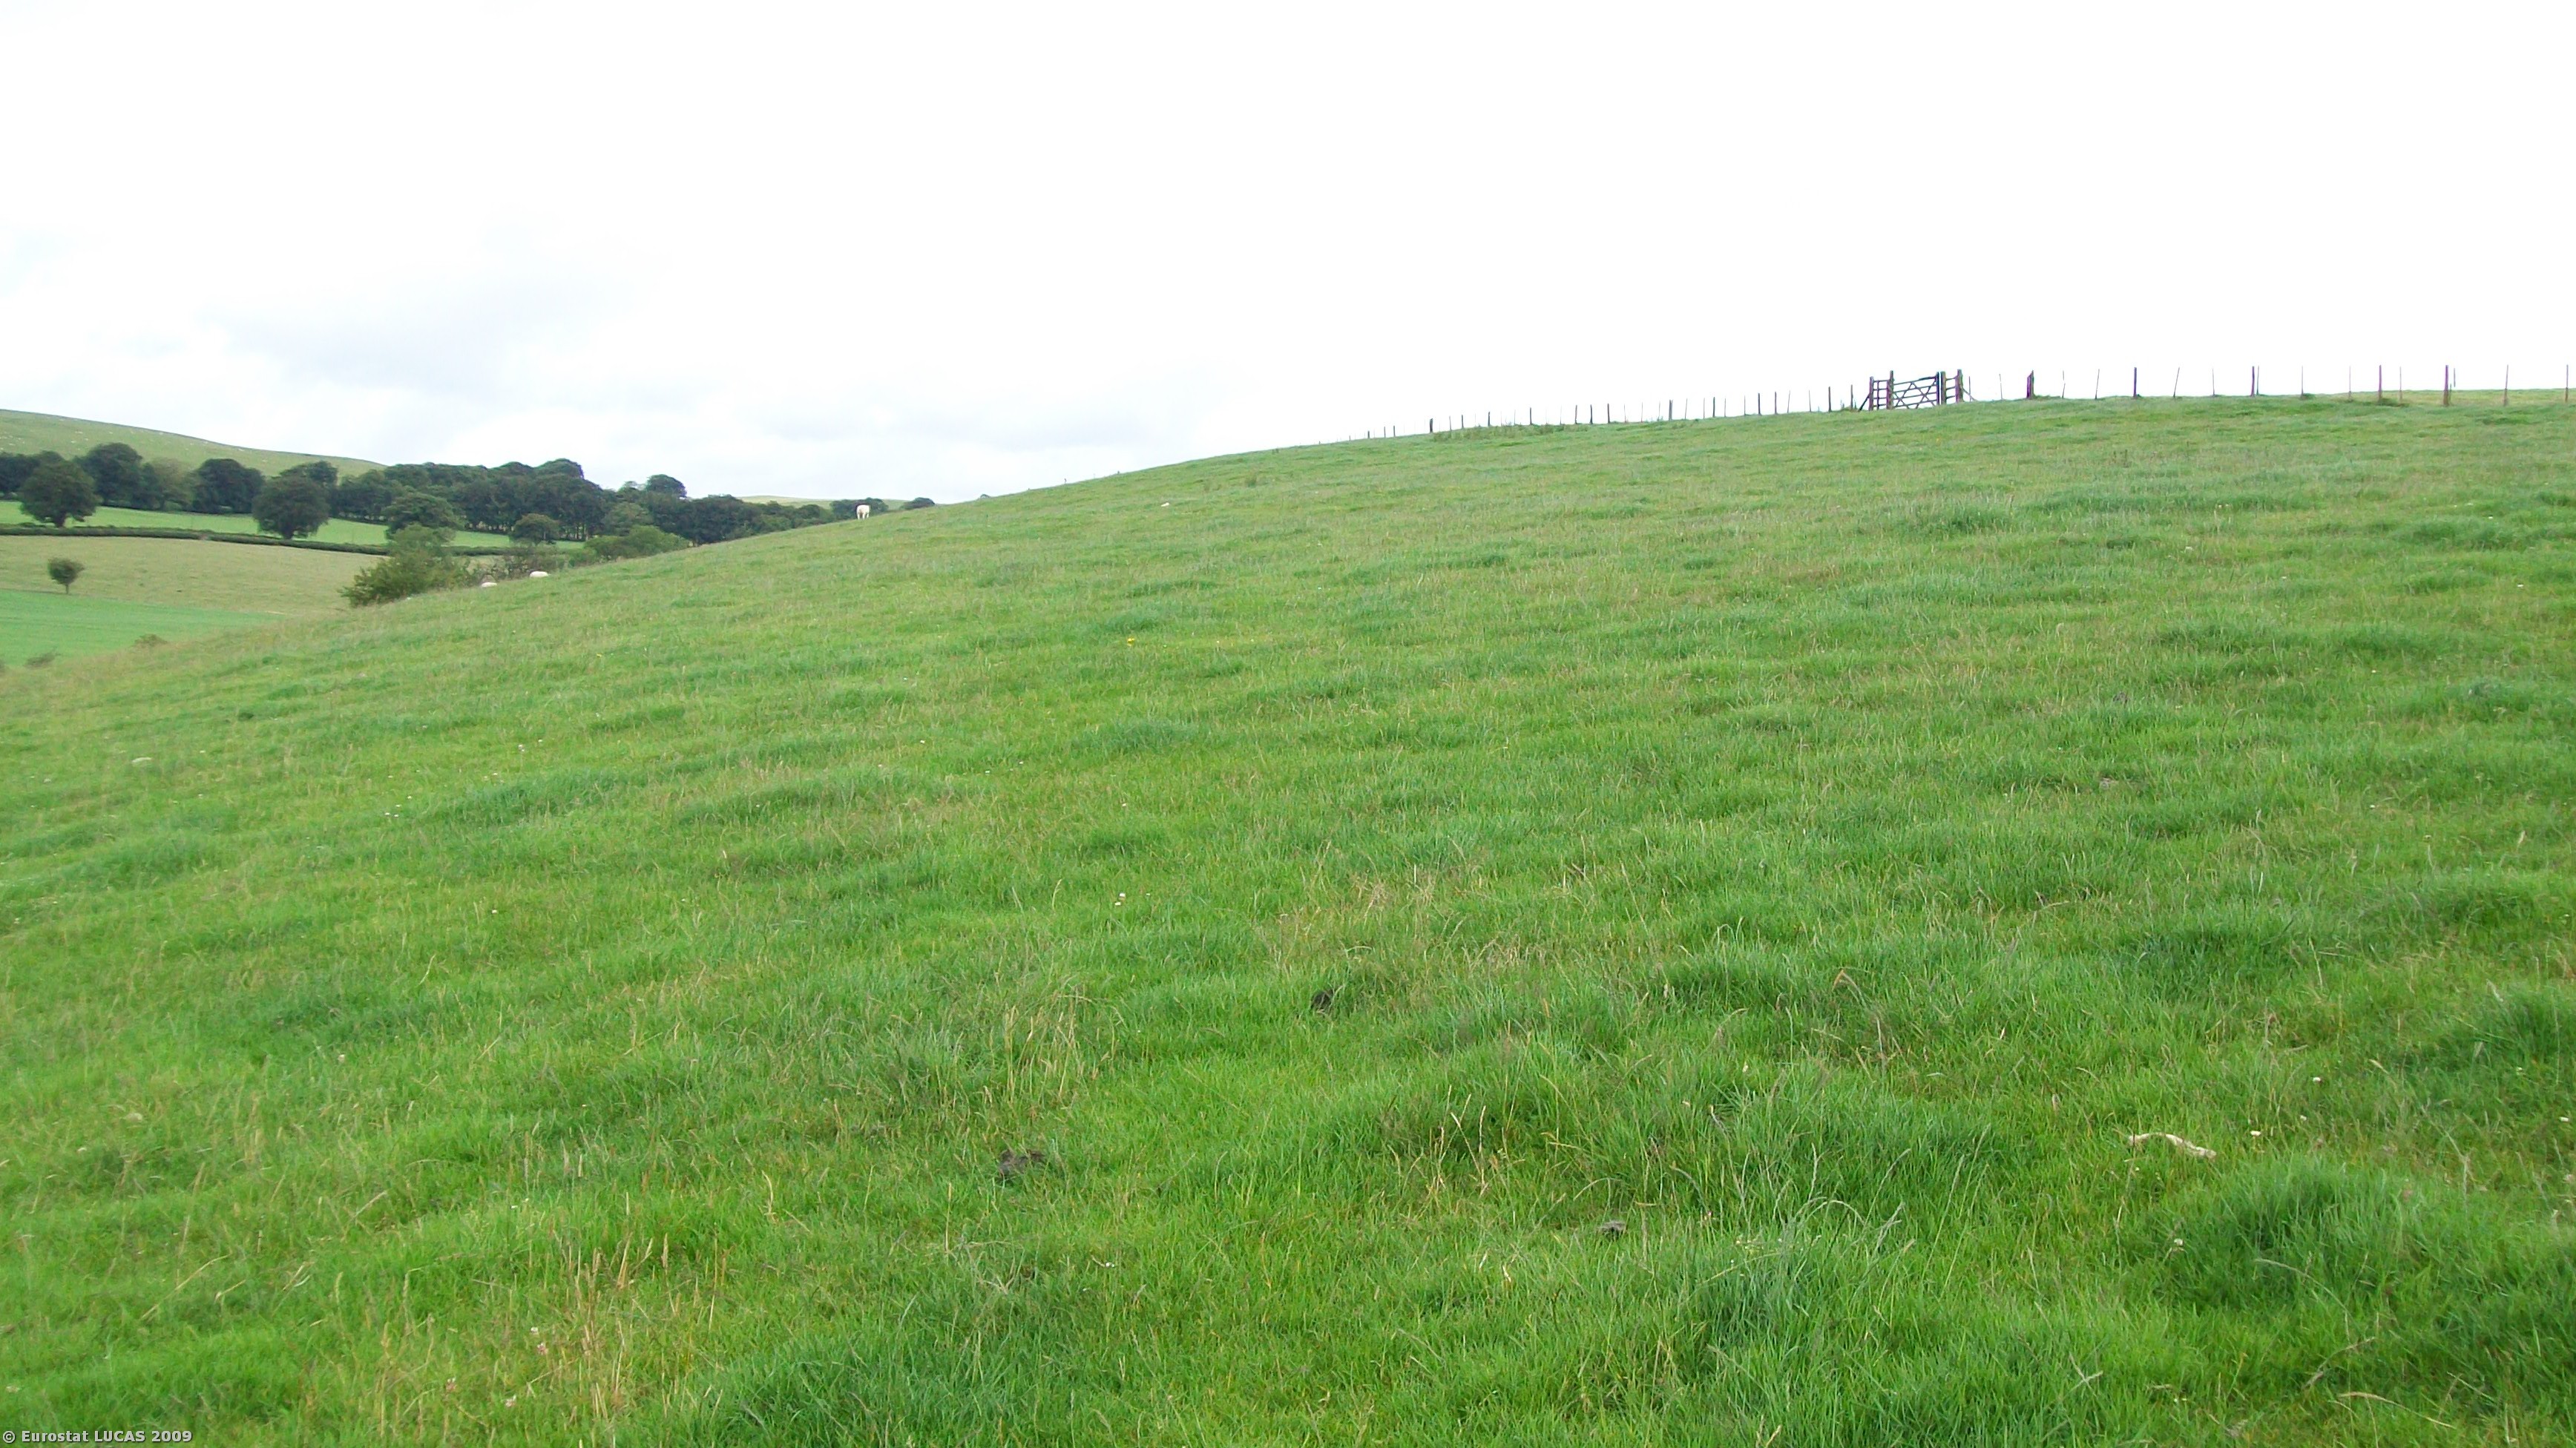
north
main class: Grassland
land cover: Grassland without tree/shrub cover
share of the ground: > 75 %
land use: Agriculture (excluding fallow land and kitchen gardens)
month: July
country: GB
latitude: 55.1234
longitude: -3.3276
